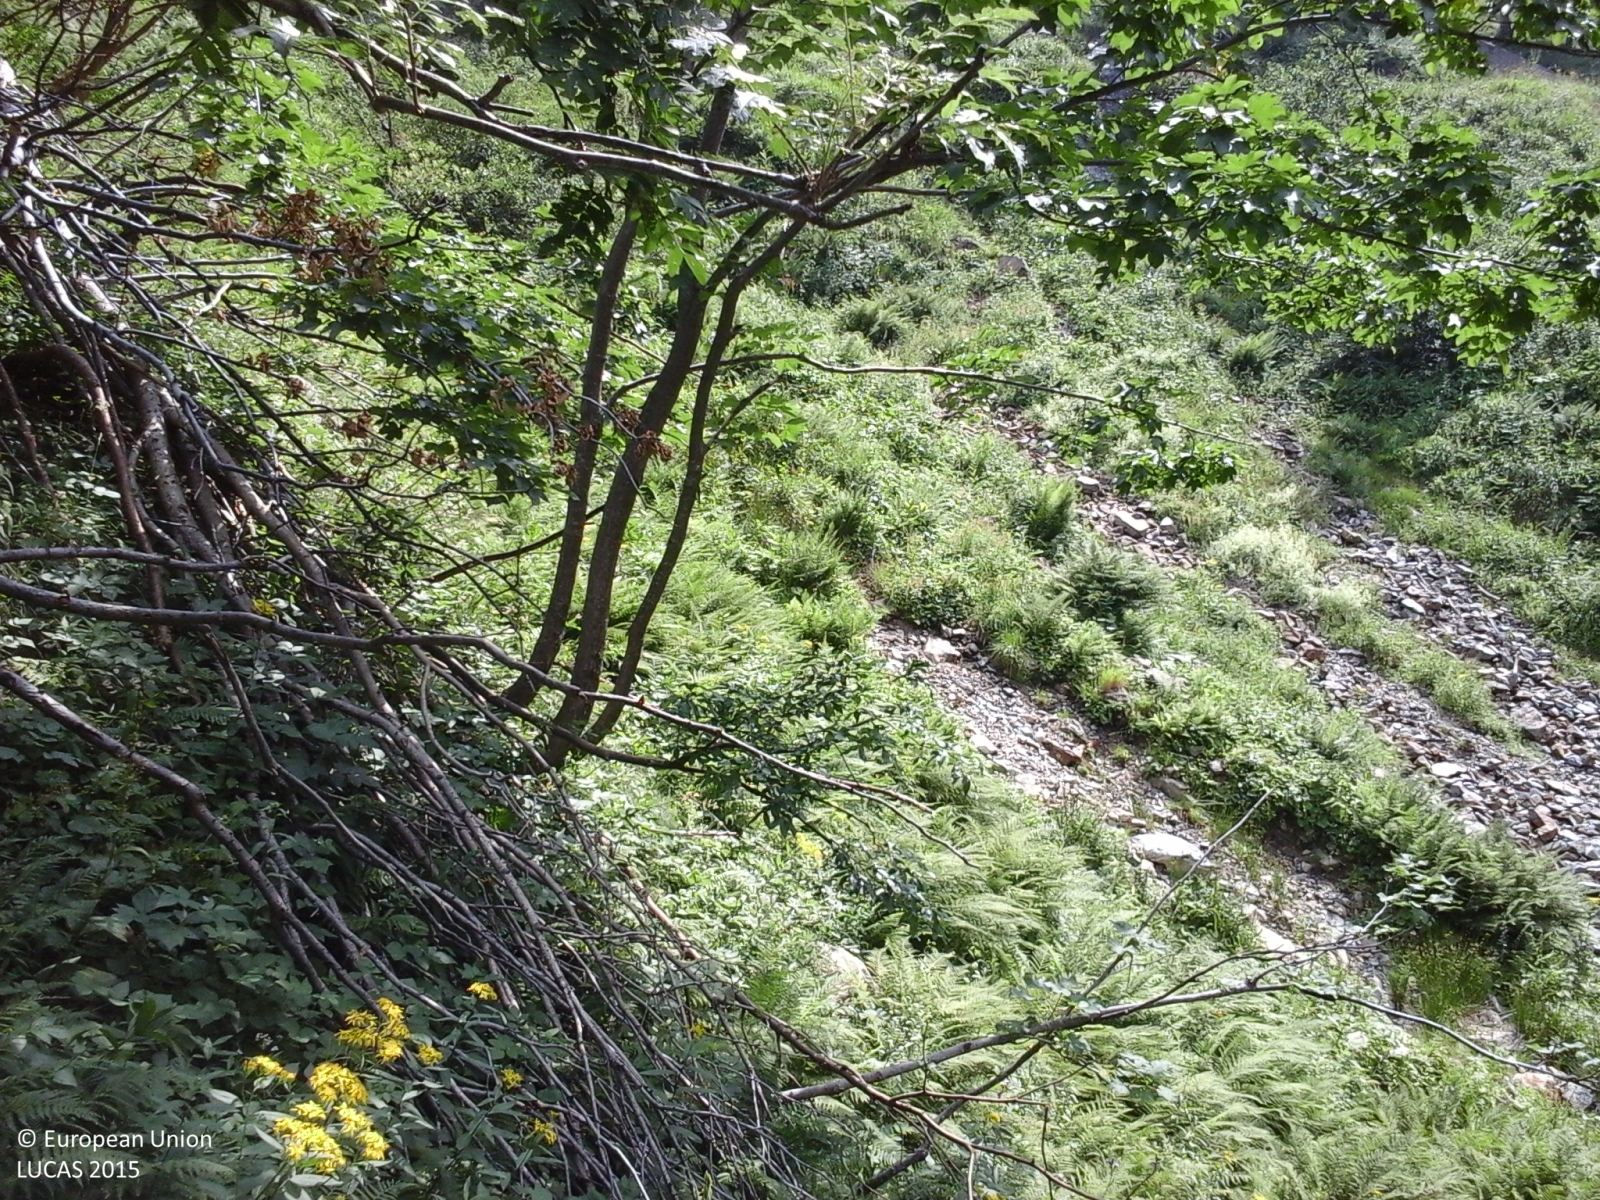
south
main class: Woodland
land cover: Broadleaved woodland
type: mountainous beech forest
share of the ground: 50 - 75 %
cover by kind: broadleaved forest trees 60 %, shrubs 20 %, consolidated bare surface 20 %
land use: Semi-natural and natural areas not in use
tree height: > 5 m
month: July
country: IT
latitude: 44.1722
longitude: 7.3418
